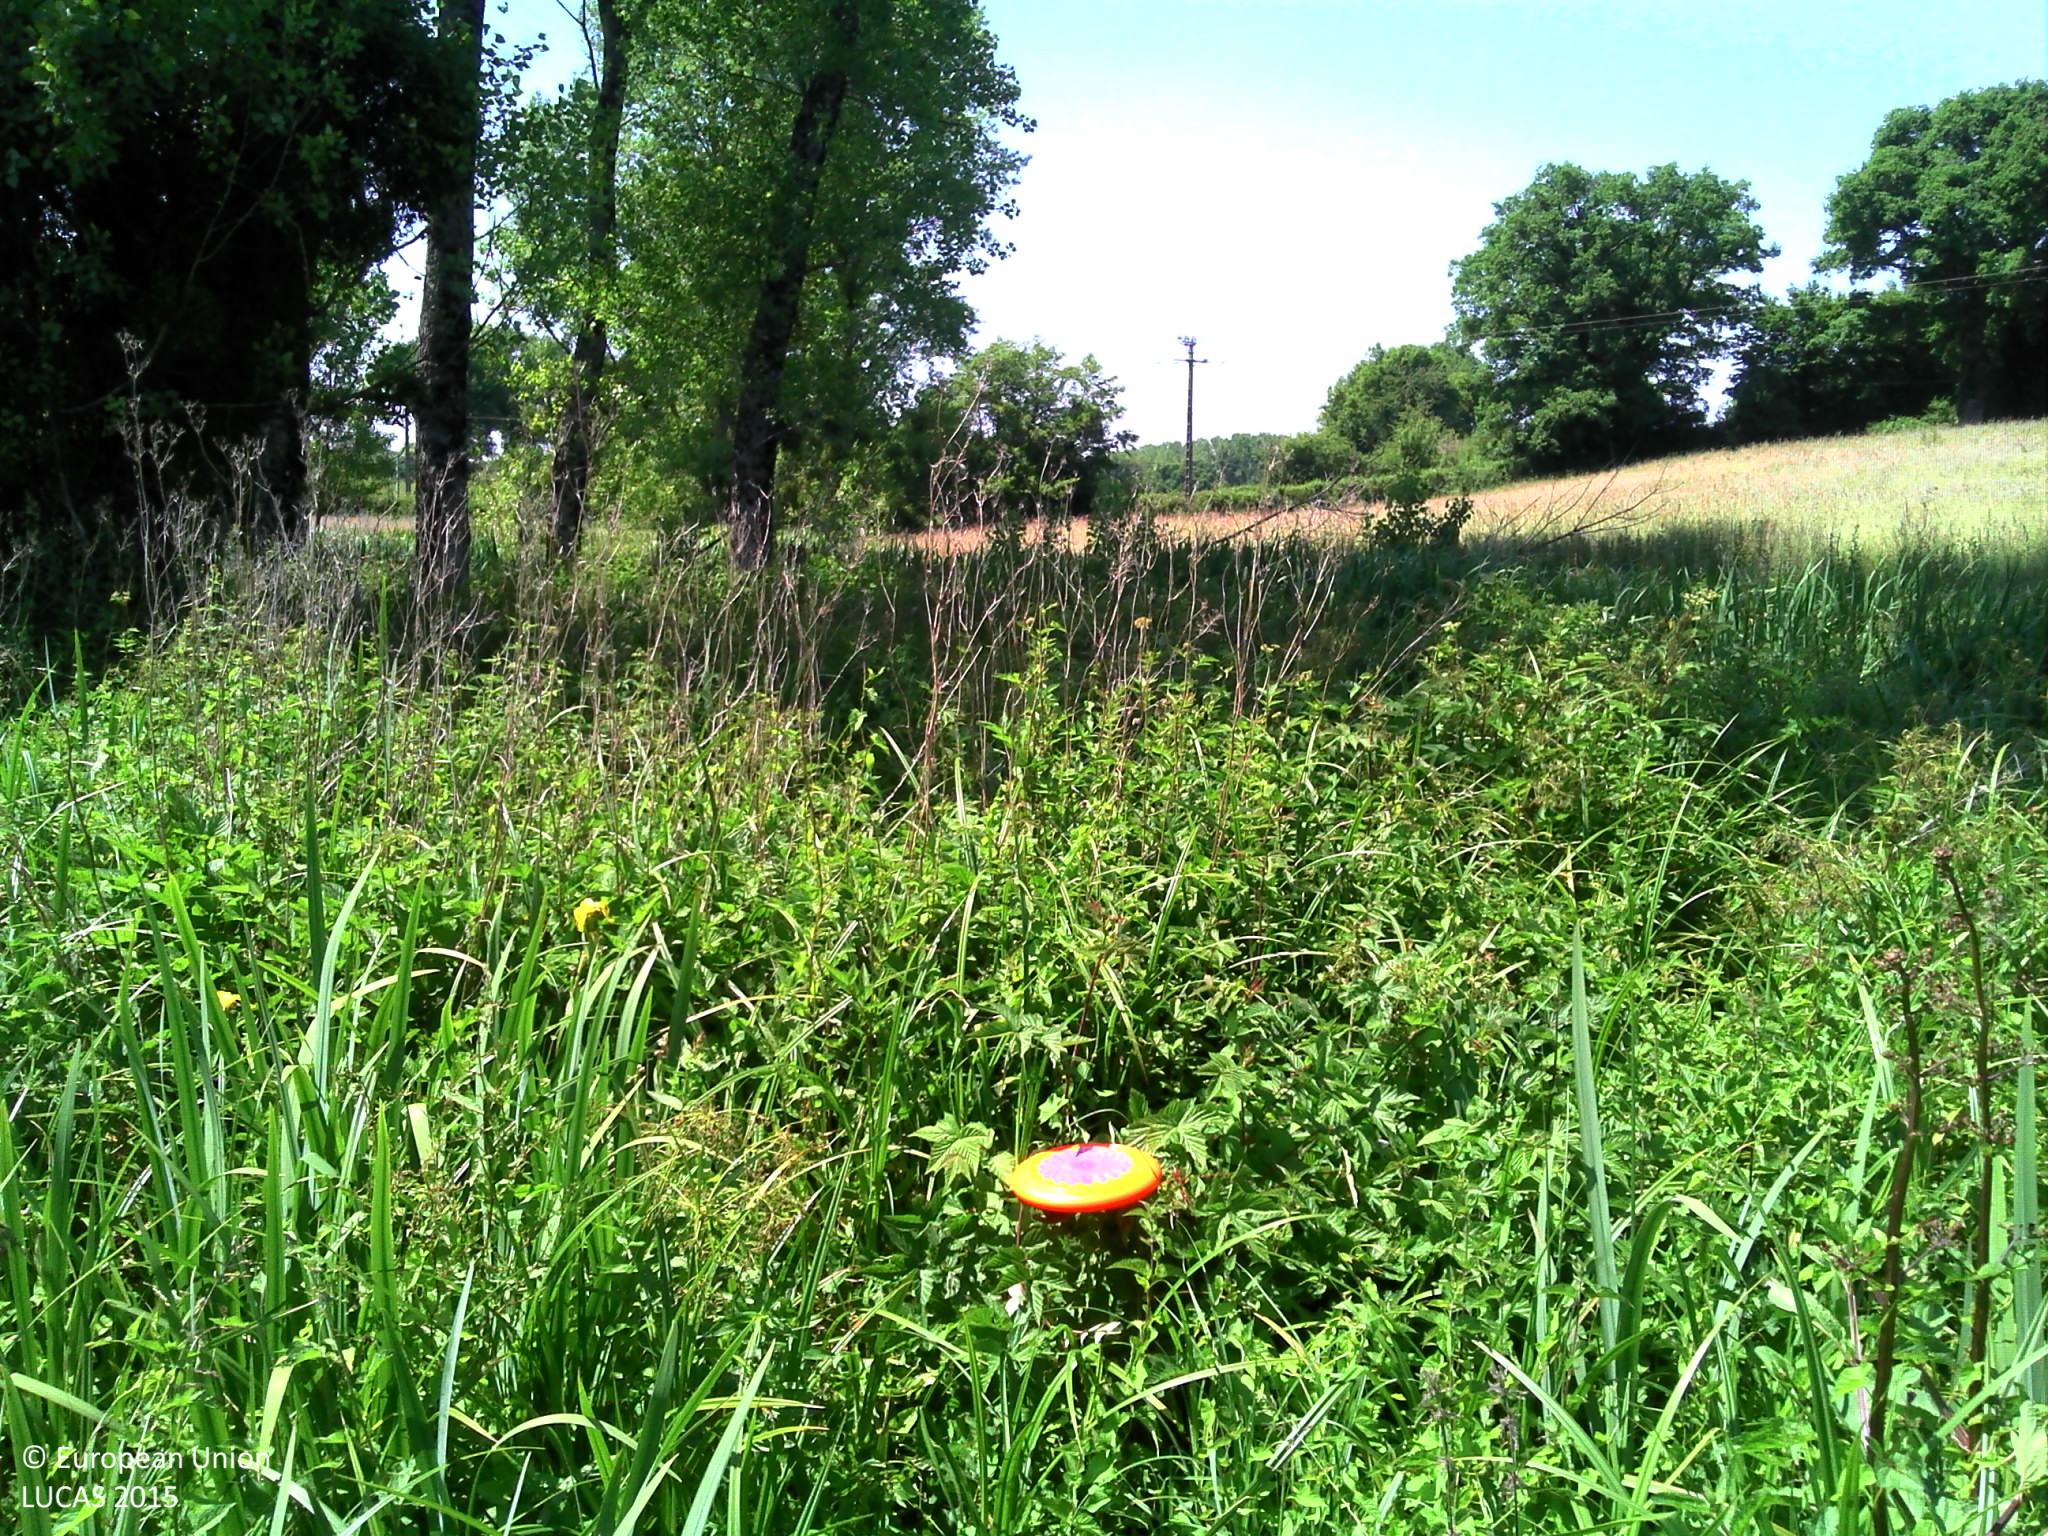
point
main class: Grassland
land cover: Spontaneously vegetated surfaces
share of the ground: > 75 %
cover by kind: herbaceous plants 95 %, shrubs 5 %
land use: Agriculture (excluding fallow land and kitchen gardens)
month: June
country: FR
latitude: 46.0577
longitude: 0.5359
